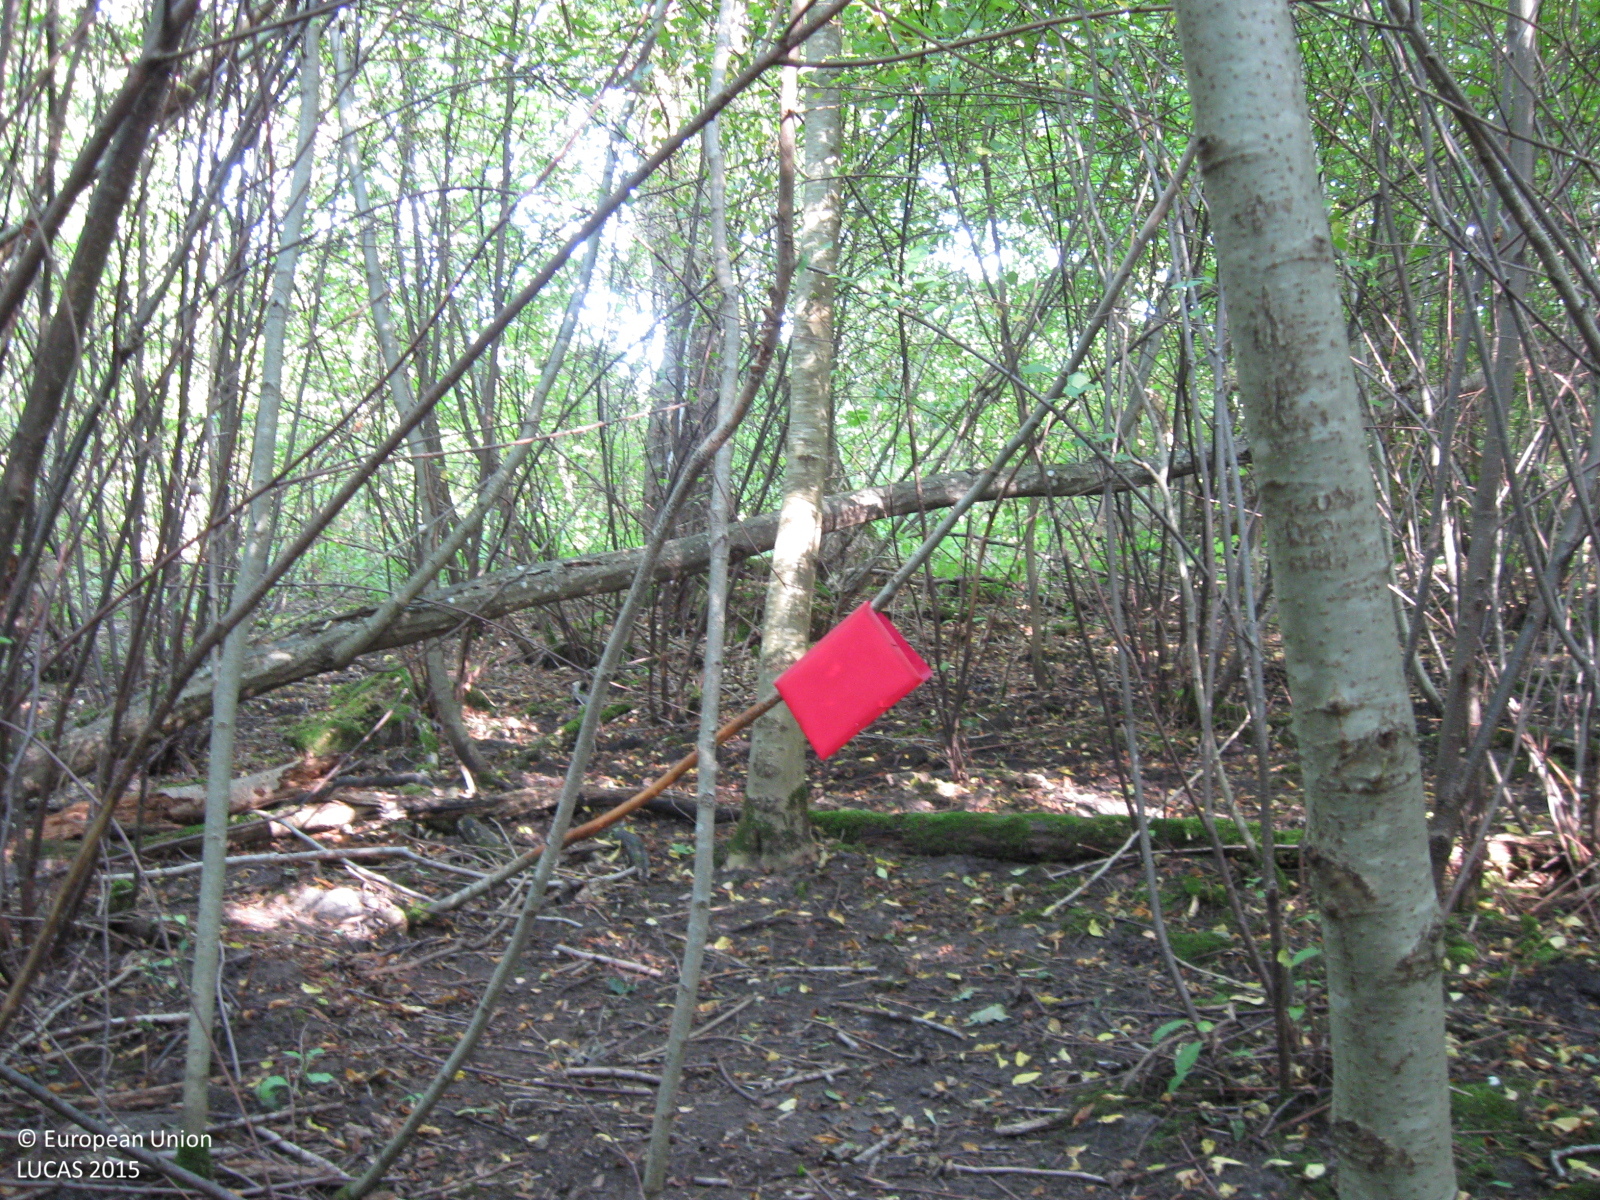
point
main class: Woodland
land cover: Broadleaved woodland
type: non-riverine alder, birch or aspen forest
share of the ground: > 75 %
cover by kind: broadleaved forest trees 95 %, unconsolidated bare surface 5 %
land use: Forestry
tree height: > 5 m
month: August
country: LT
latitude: 55.4636
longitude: 23.2169
